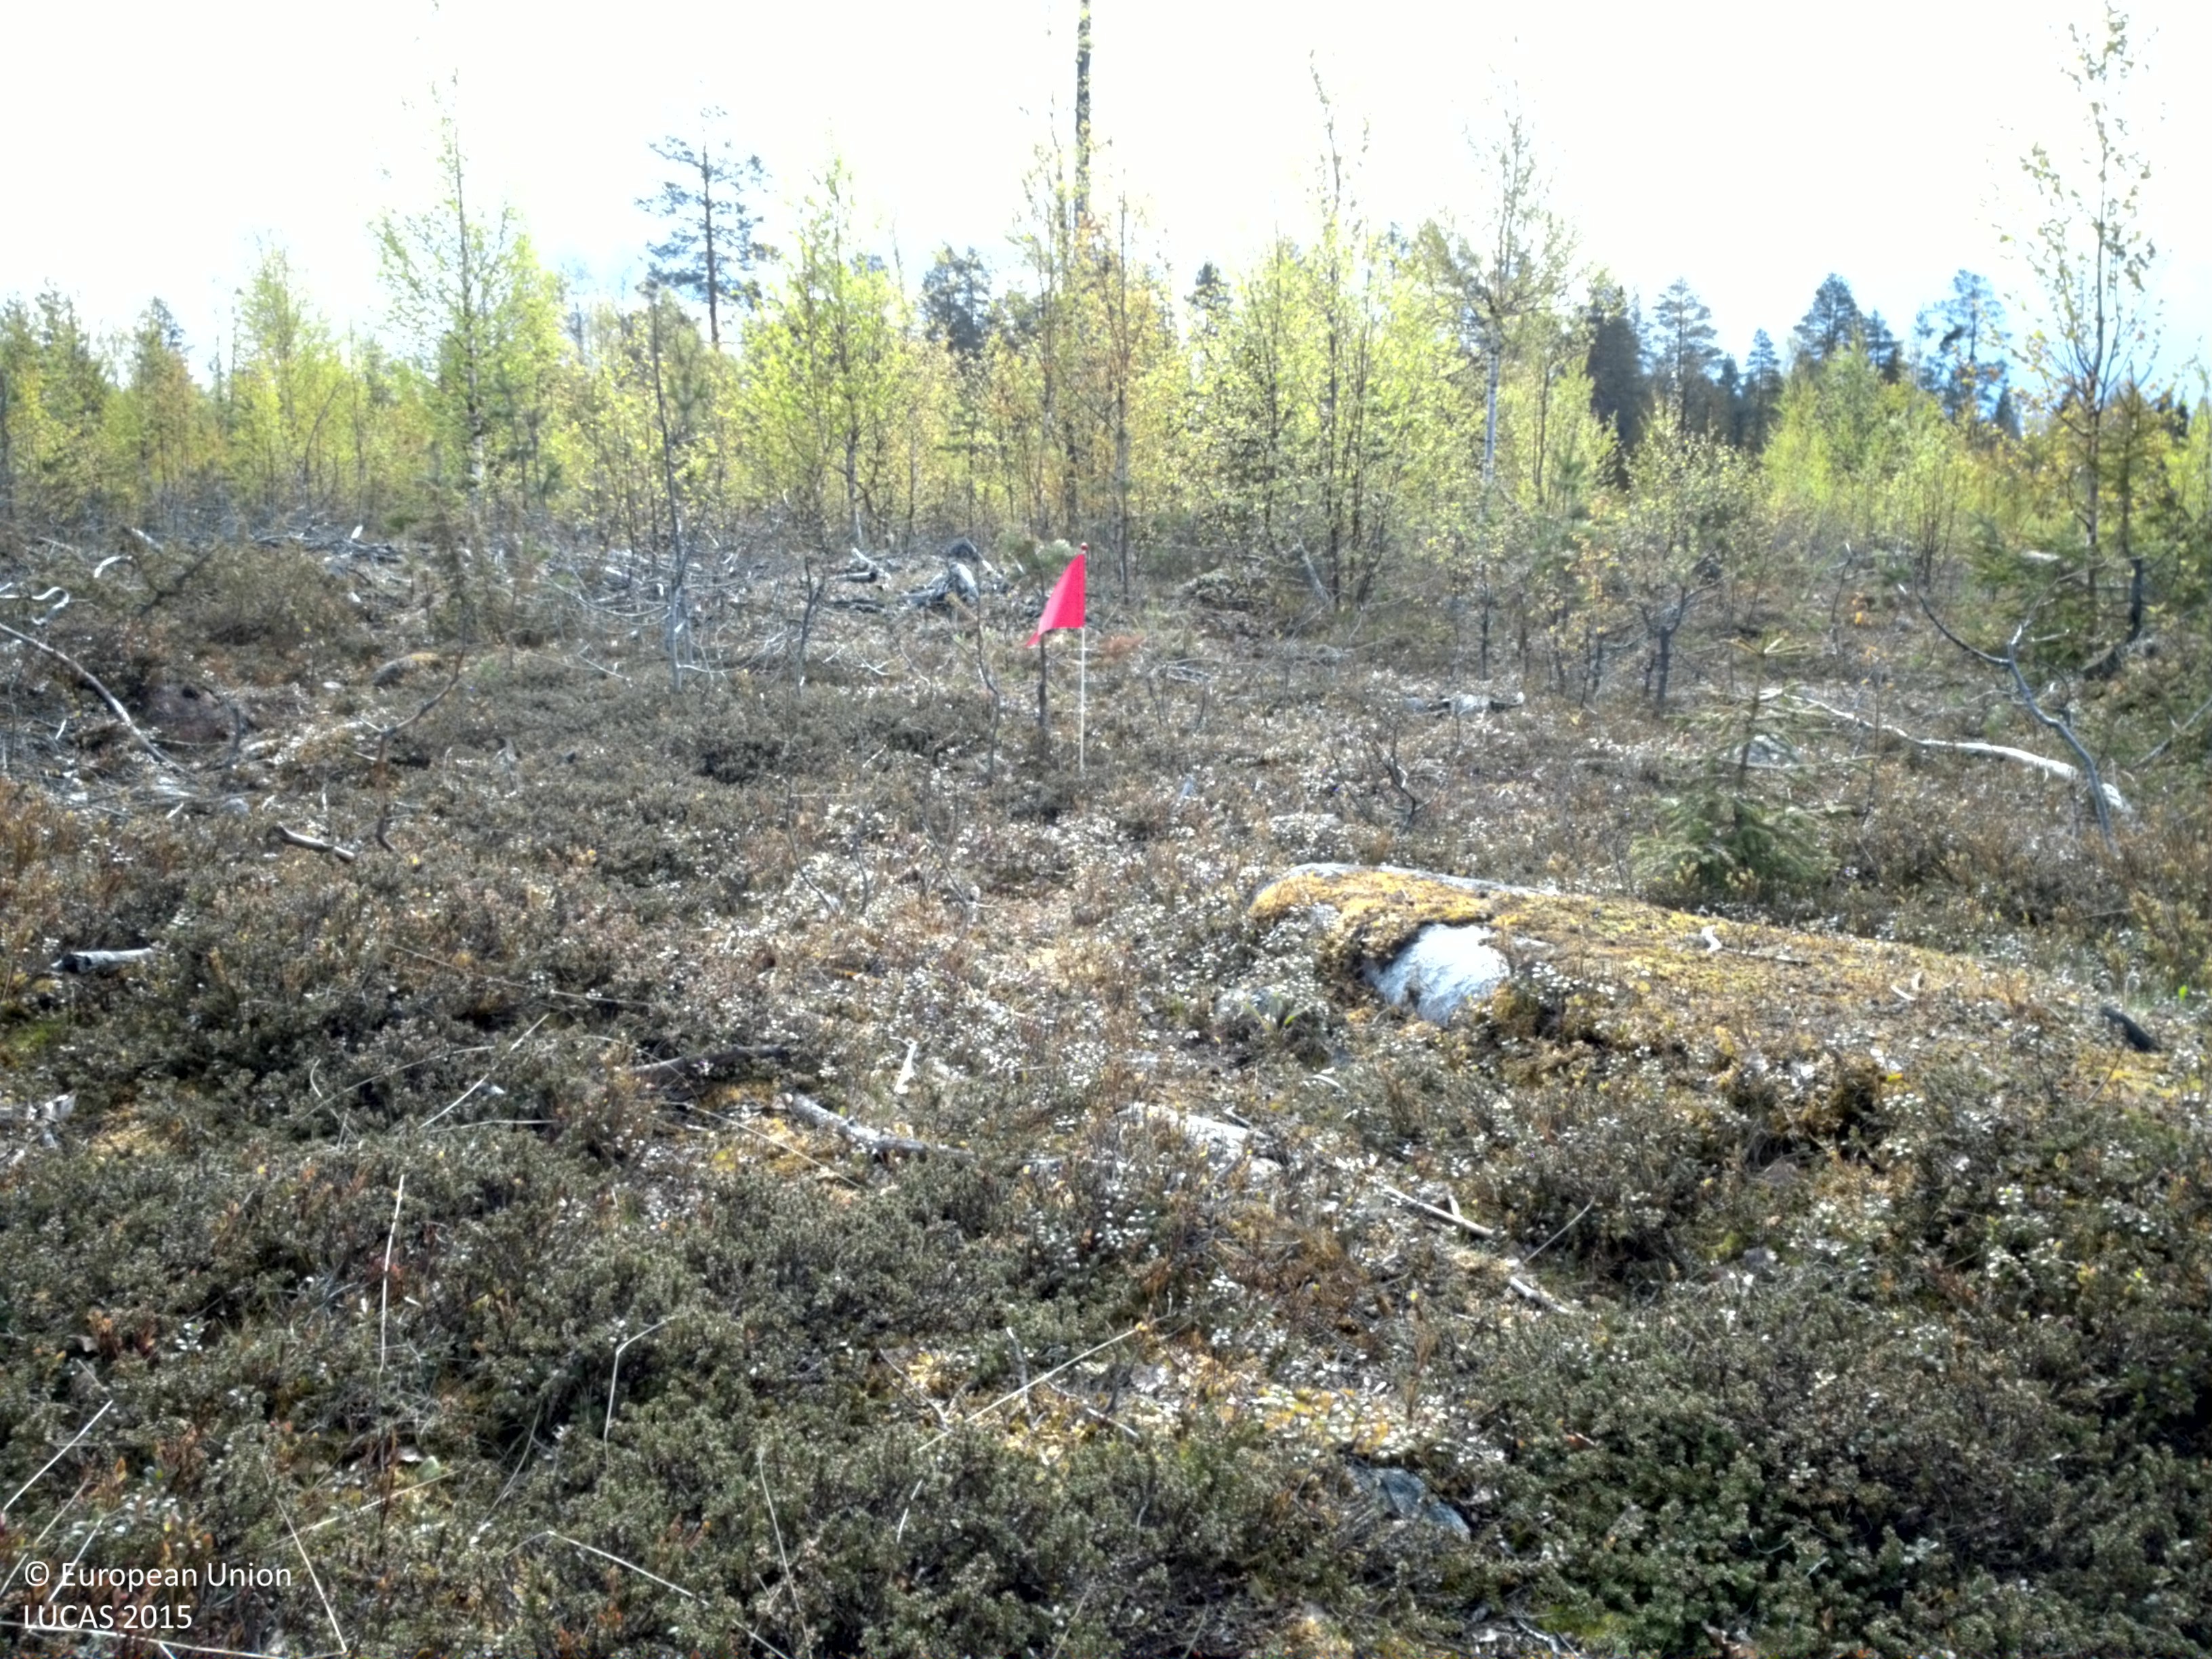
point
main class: Woodland
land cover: Pine dominated mixed woodland
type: boreal forest
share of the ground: 10 - 25 %
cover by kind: shrubs 75 %, broadleaved forest trees 15 %, coniferous forest trees 10 %
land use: Forestry
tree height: < 5 m
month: June
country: SE
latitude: 66.4240
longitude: 23.3594
